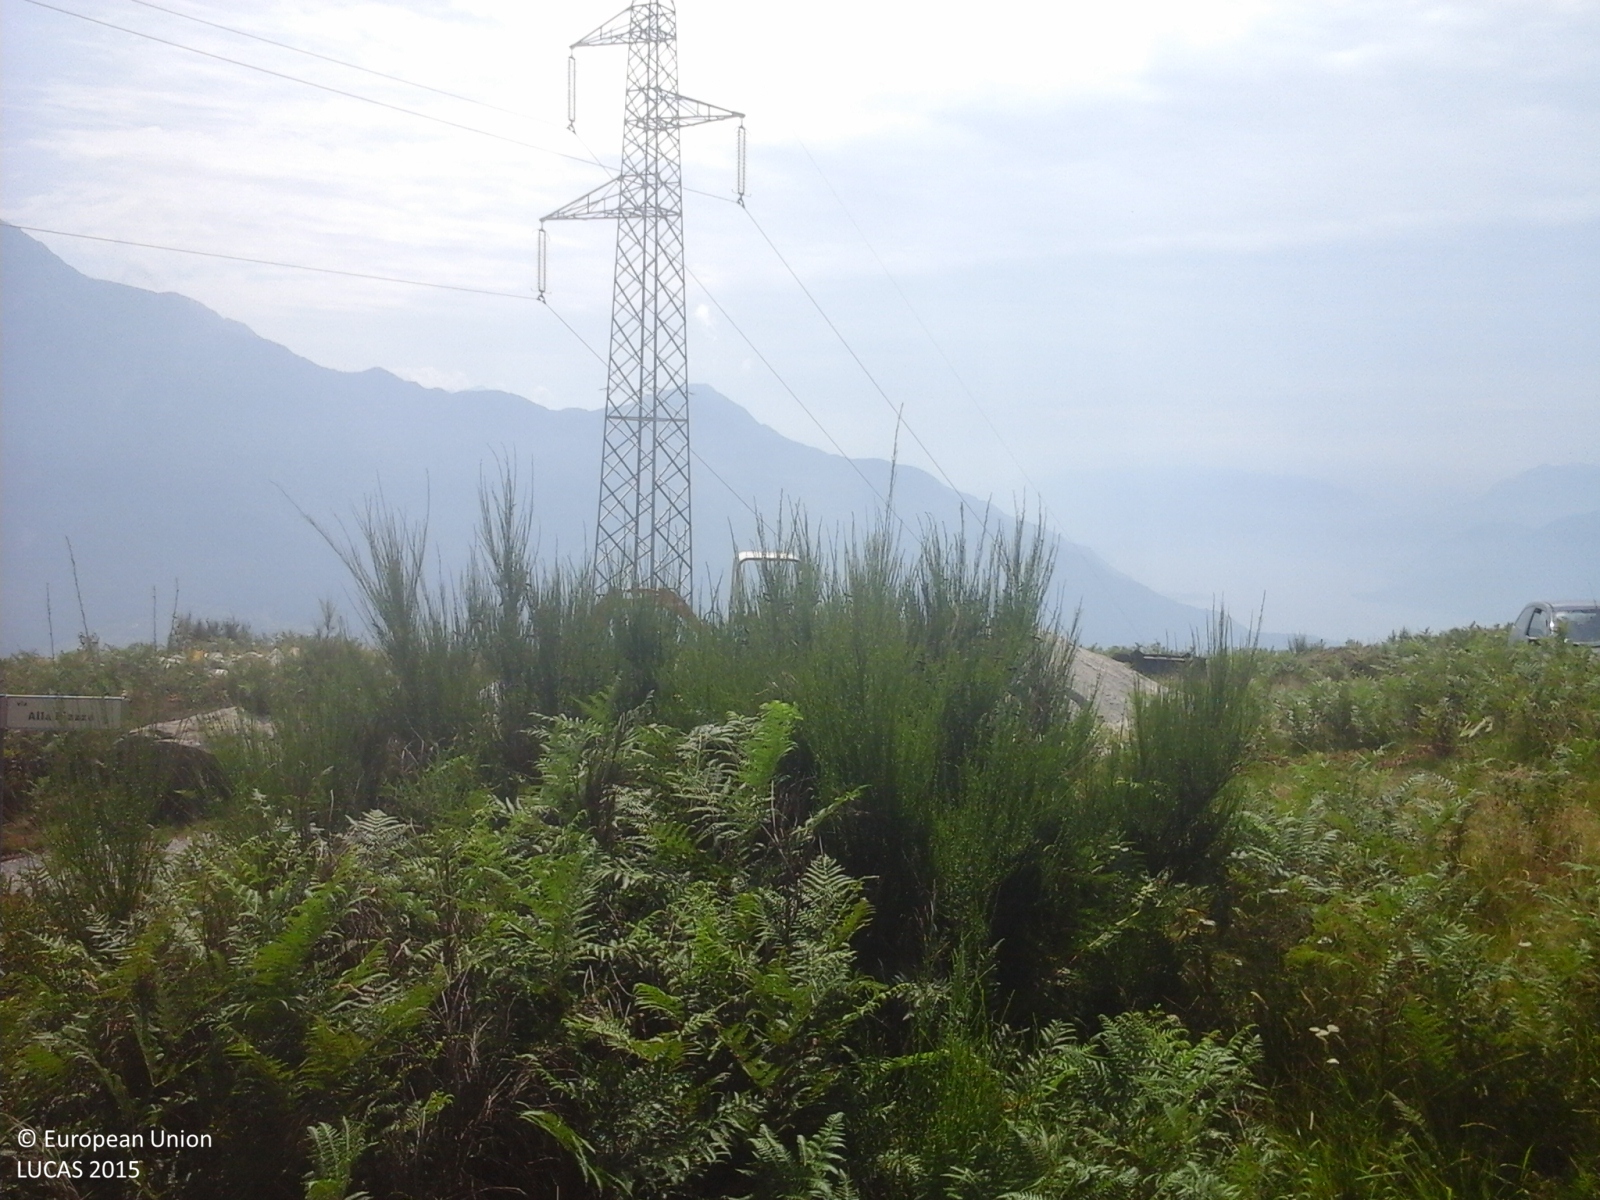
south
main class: Shrubland
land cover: Shrubland without tree cover
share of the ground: > 75 %
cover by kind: herbaceous plants 80 %, shrubs 20 %
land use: Semi-natural and natural areas not in use
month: August
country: IT
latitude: 46.1872
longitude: 9.3660
